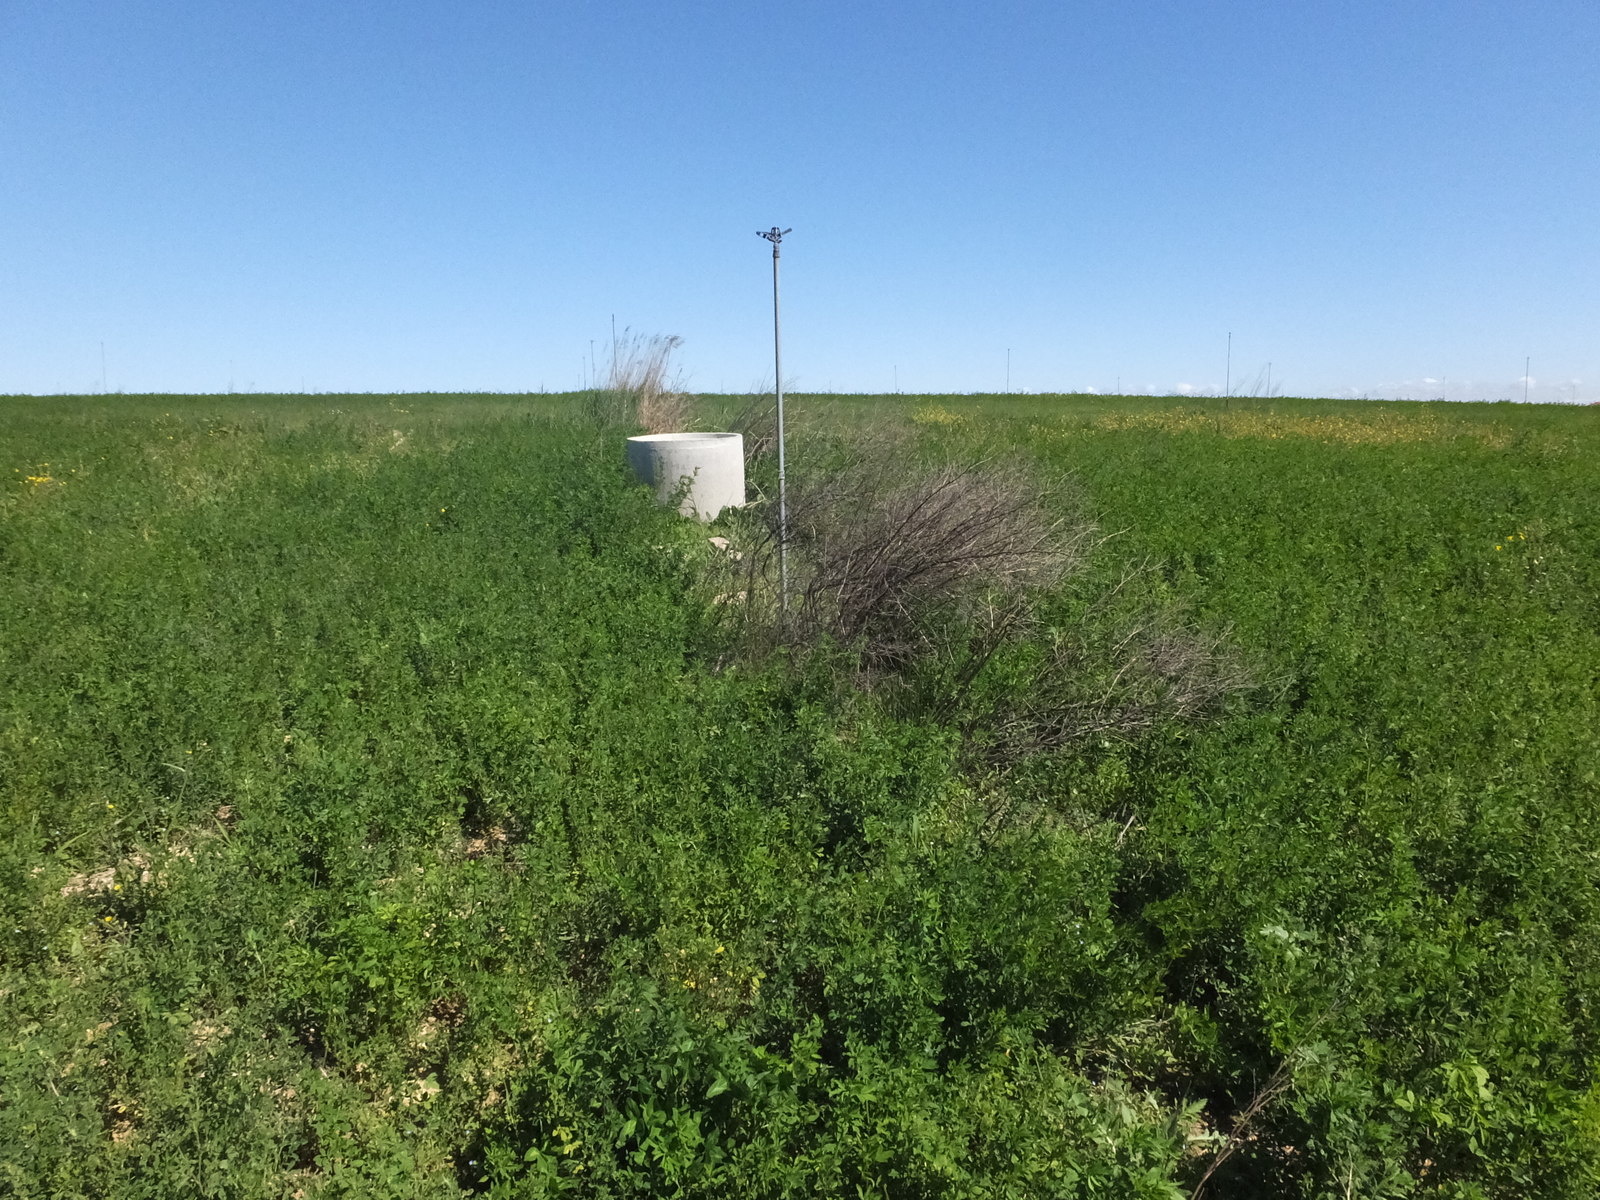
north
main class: Cropland
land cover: Lucerne
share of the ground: > 75 %
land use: Agriculture (excluding fallow land and kitchen gardens)
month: April
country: ES
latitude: 41.8195
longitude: -0.2882
